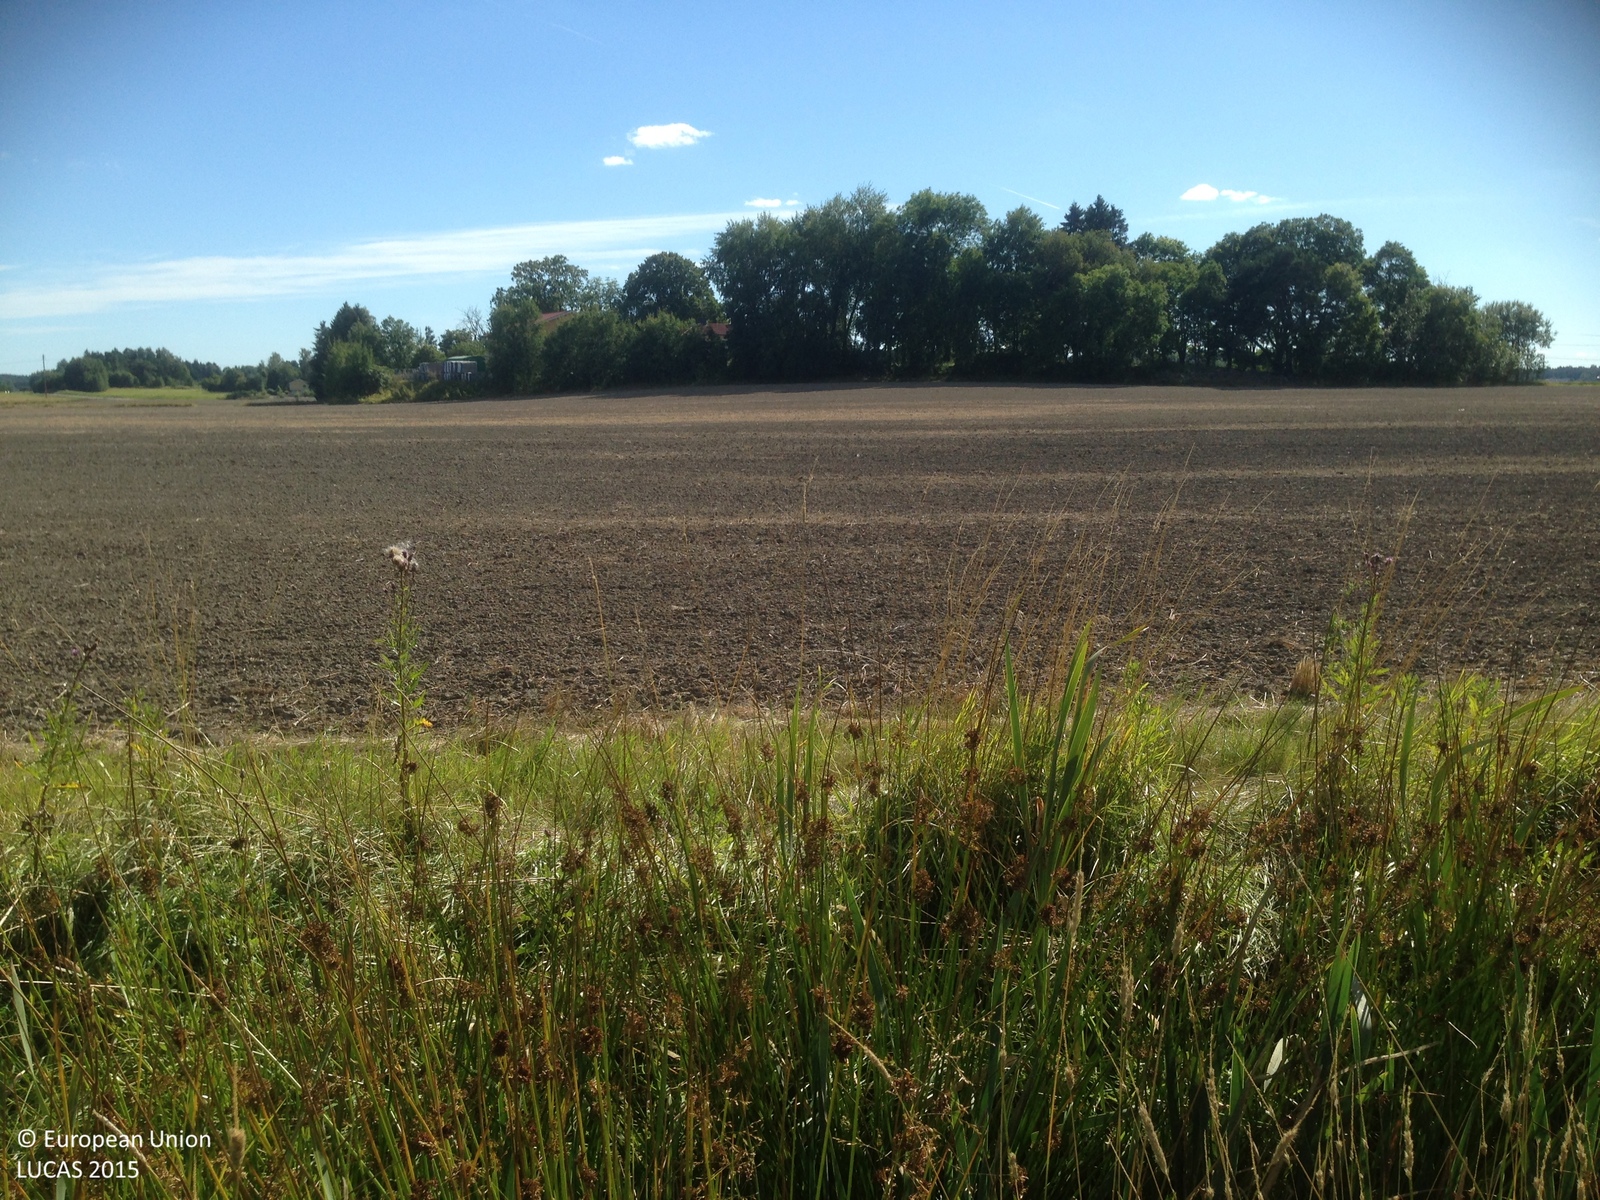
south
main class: Cropland
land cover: Oats
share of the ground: > 75 %
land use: Agriculture (excluding fallow land and kitchen gardens)
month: August
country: SE
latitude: 59.6538
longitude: 17.8573
